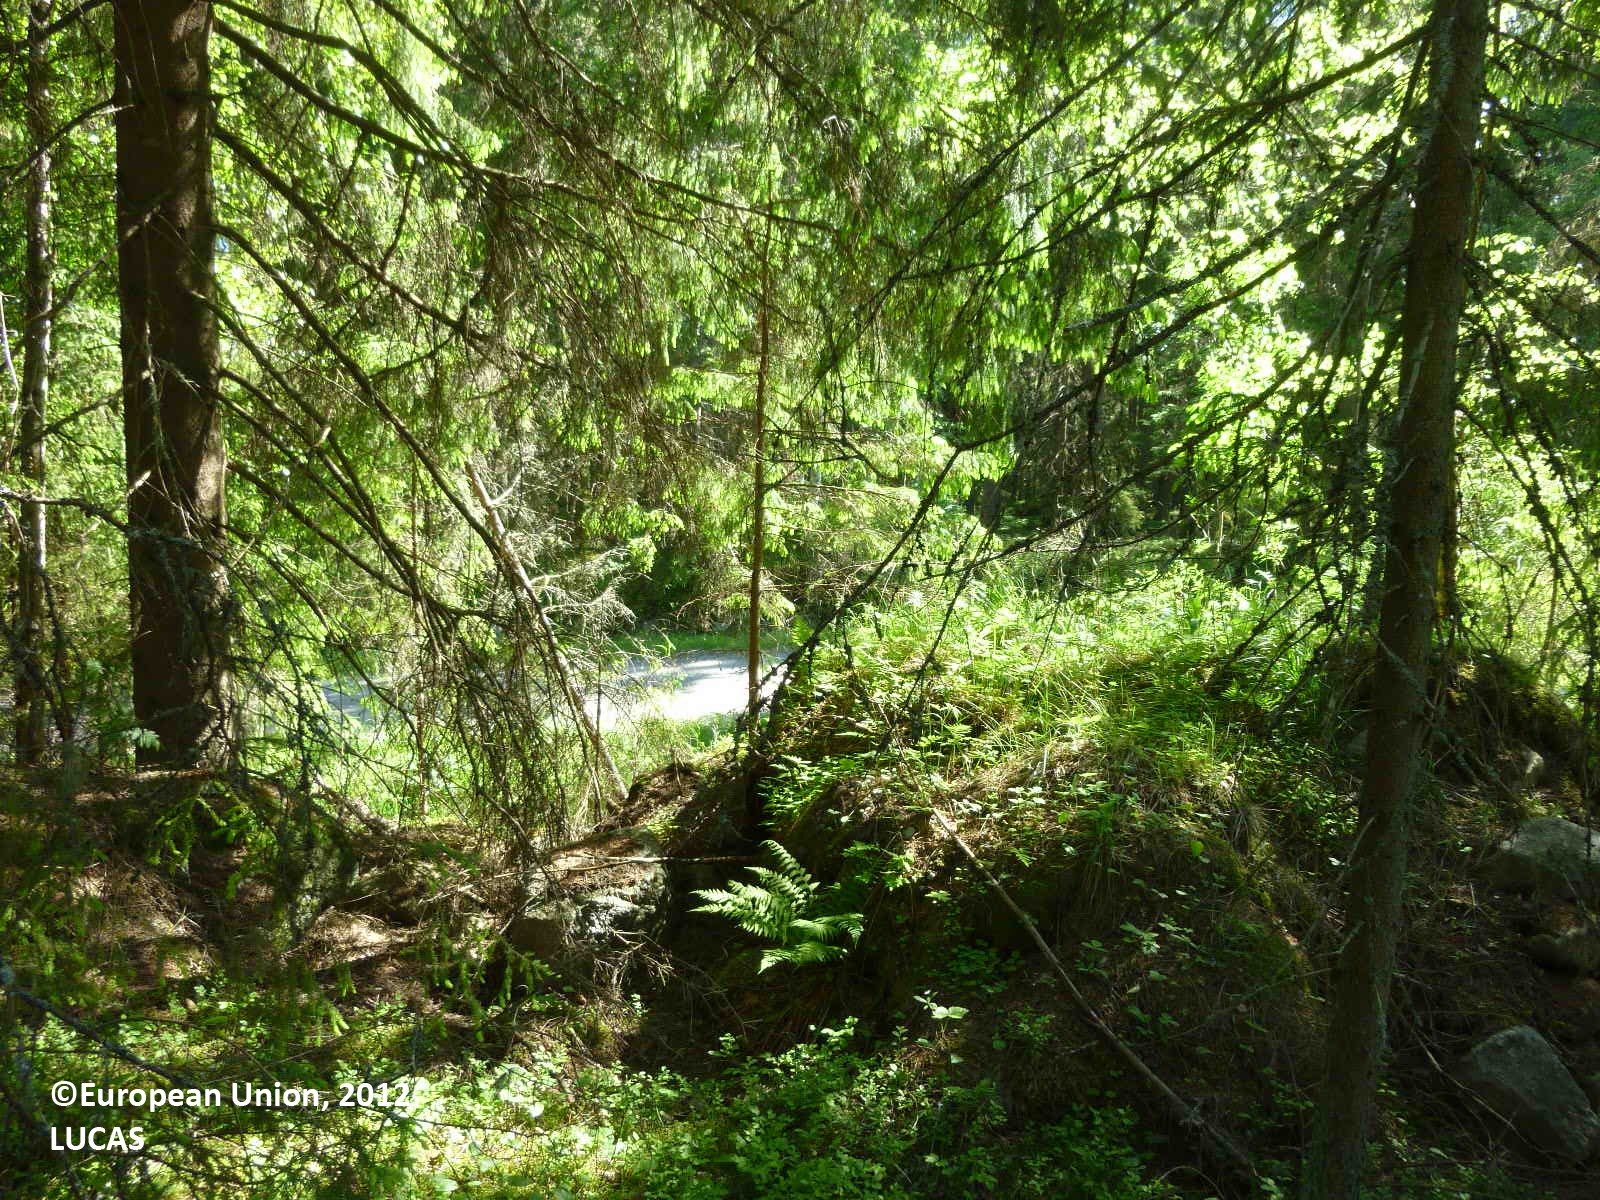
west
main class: Woodland
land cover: Spruce dominated coniferous woodland
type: boreal forest
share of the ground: > 75 %
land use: Forestry
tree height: > 5 m
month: June
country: FI
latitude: 61.4940
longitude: 22.8220
